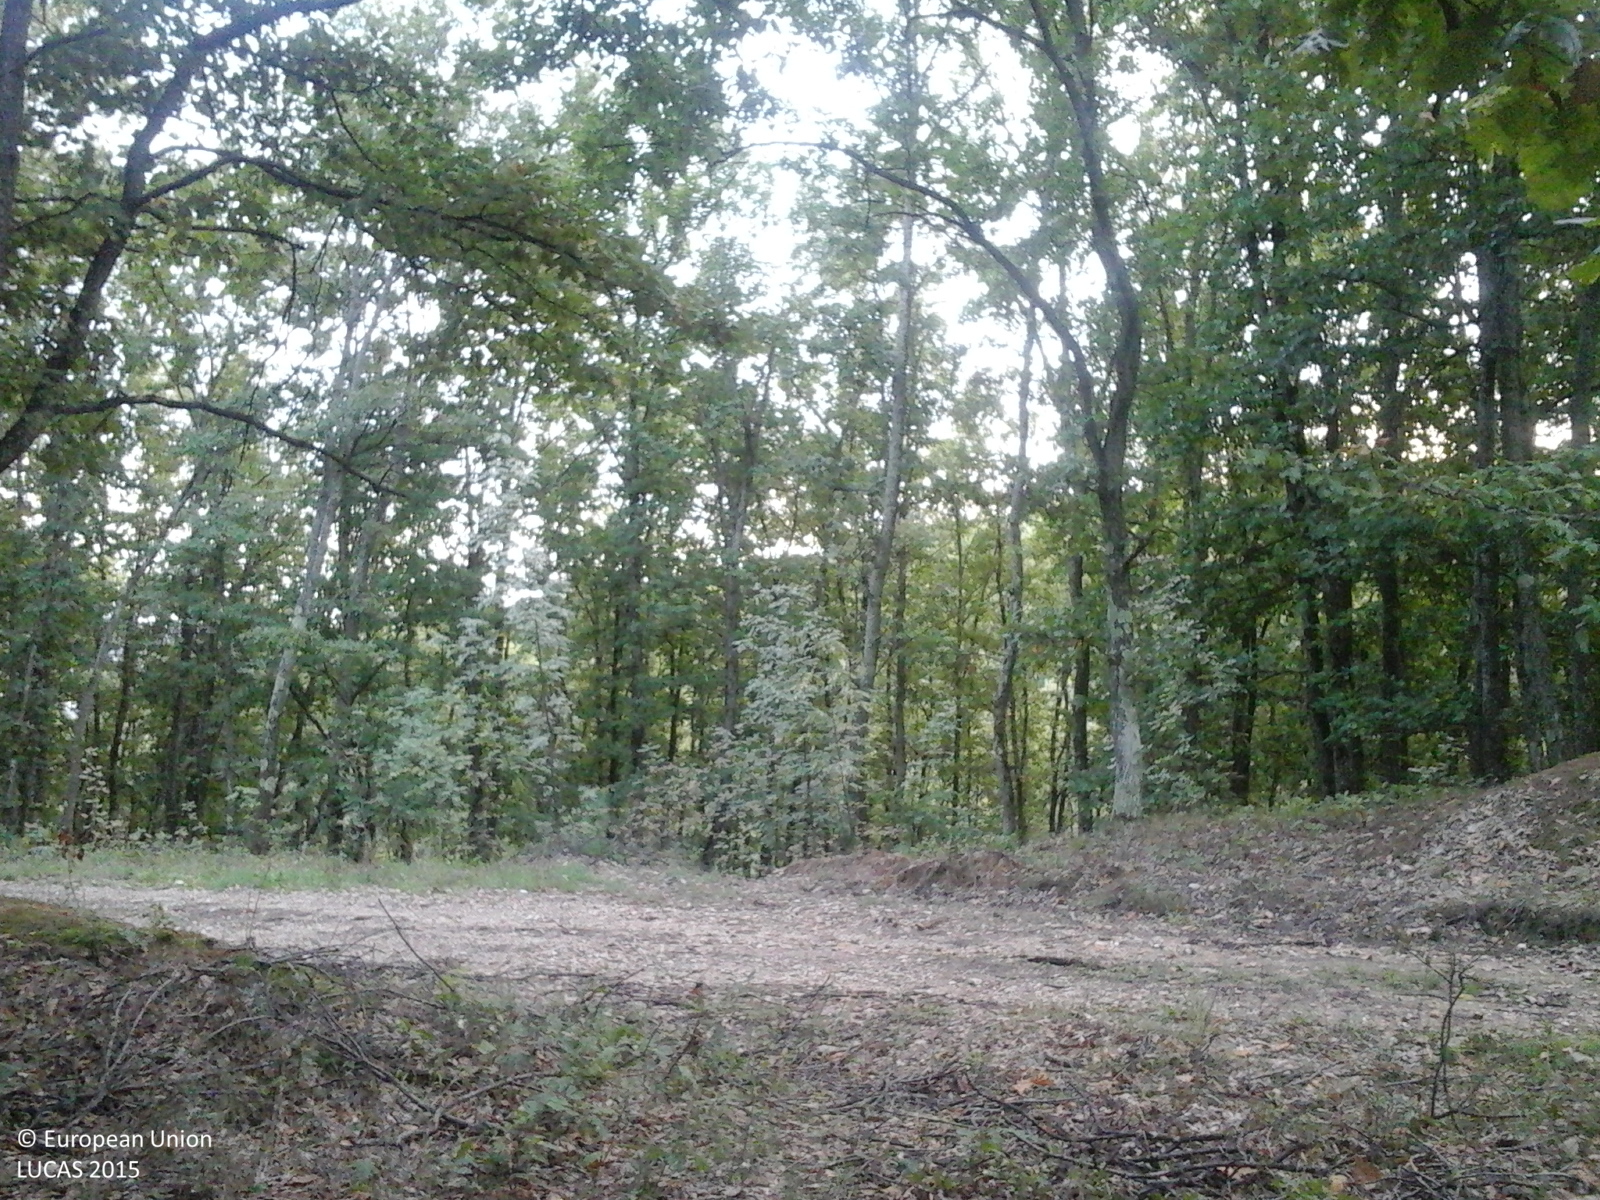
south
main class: Woodland
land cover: Broadleaved woodland
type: acidophilous oak and oak-birch forest
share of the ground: > 75 %
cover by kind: broadleaved forest trees 100 %
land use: Forestry
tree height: > 5 m
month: September
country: RO
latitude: 44.9025
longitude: 23.3904
